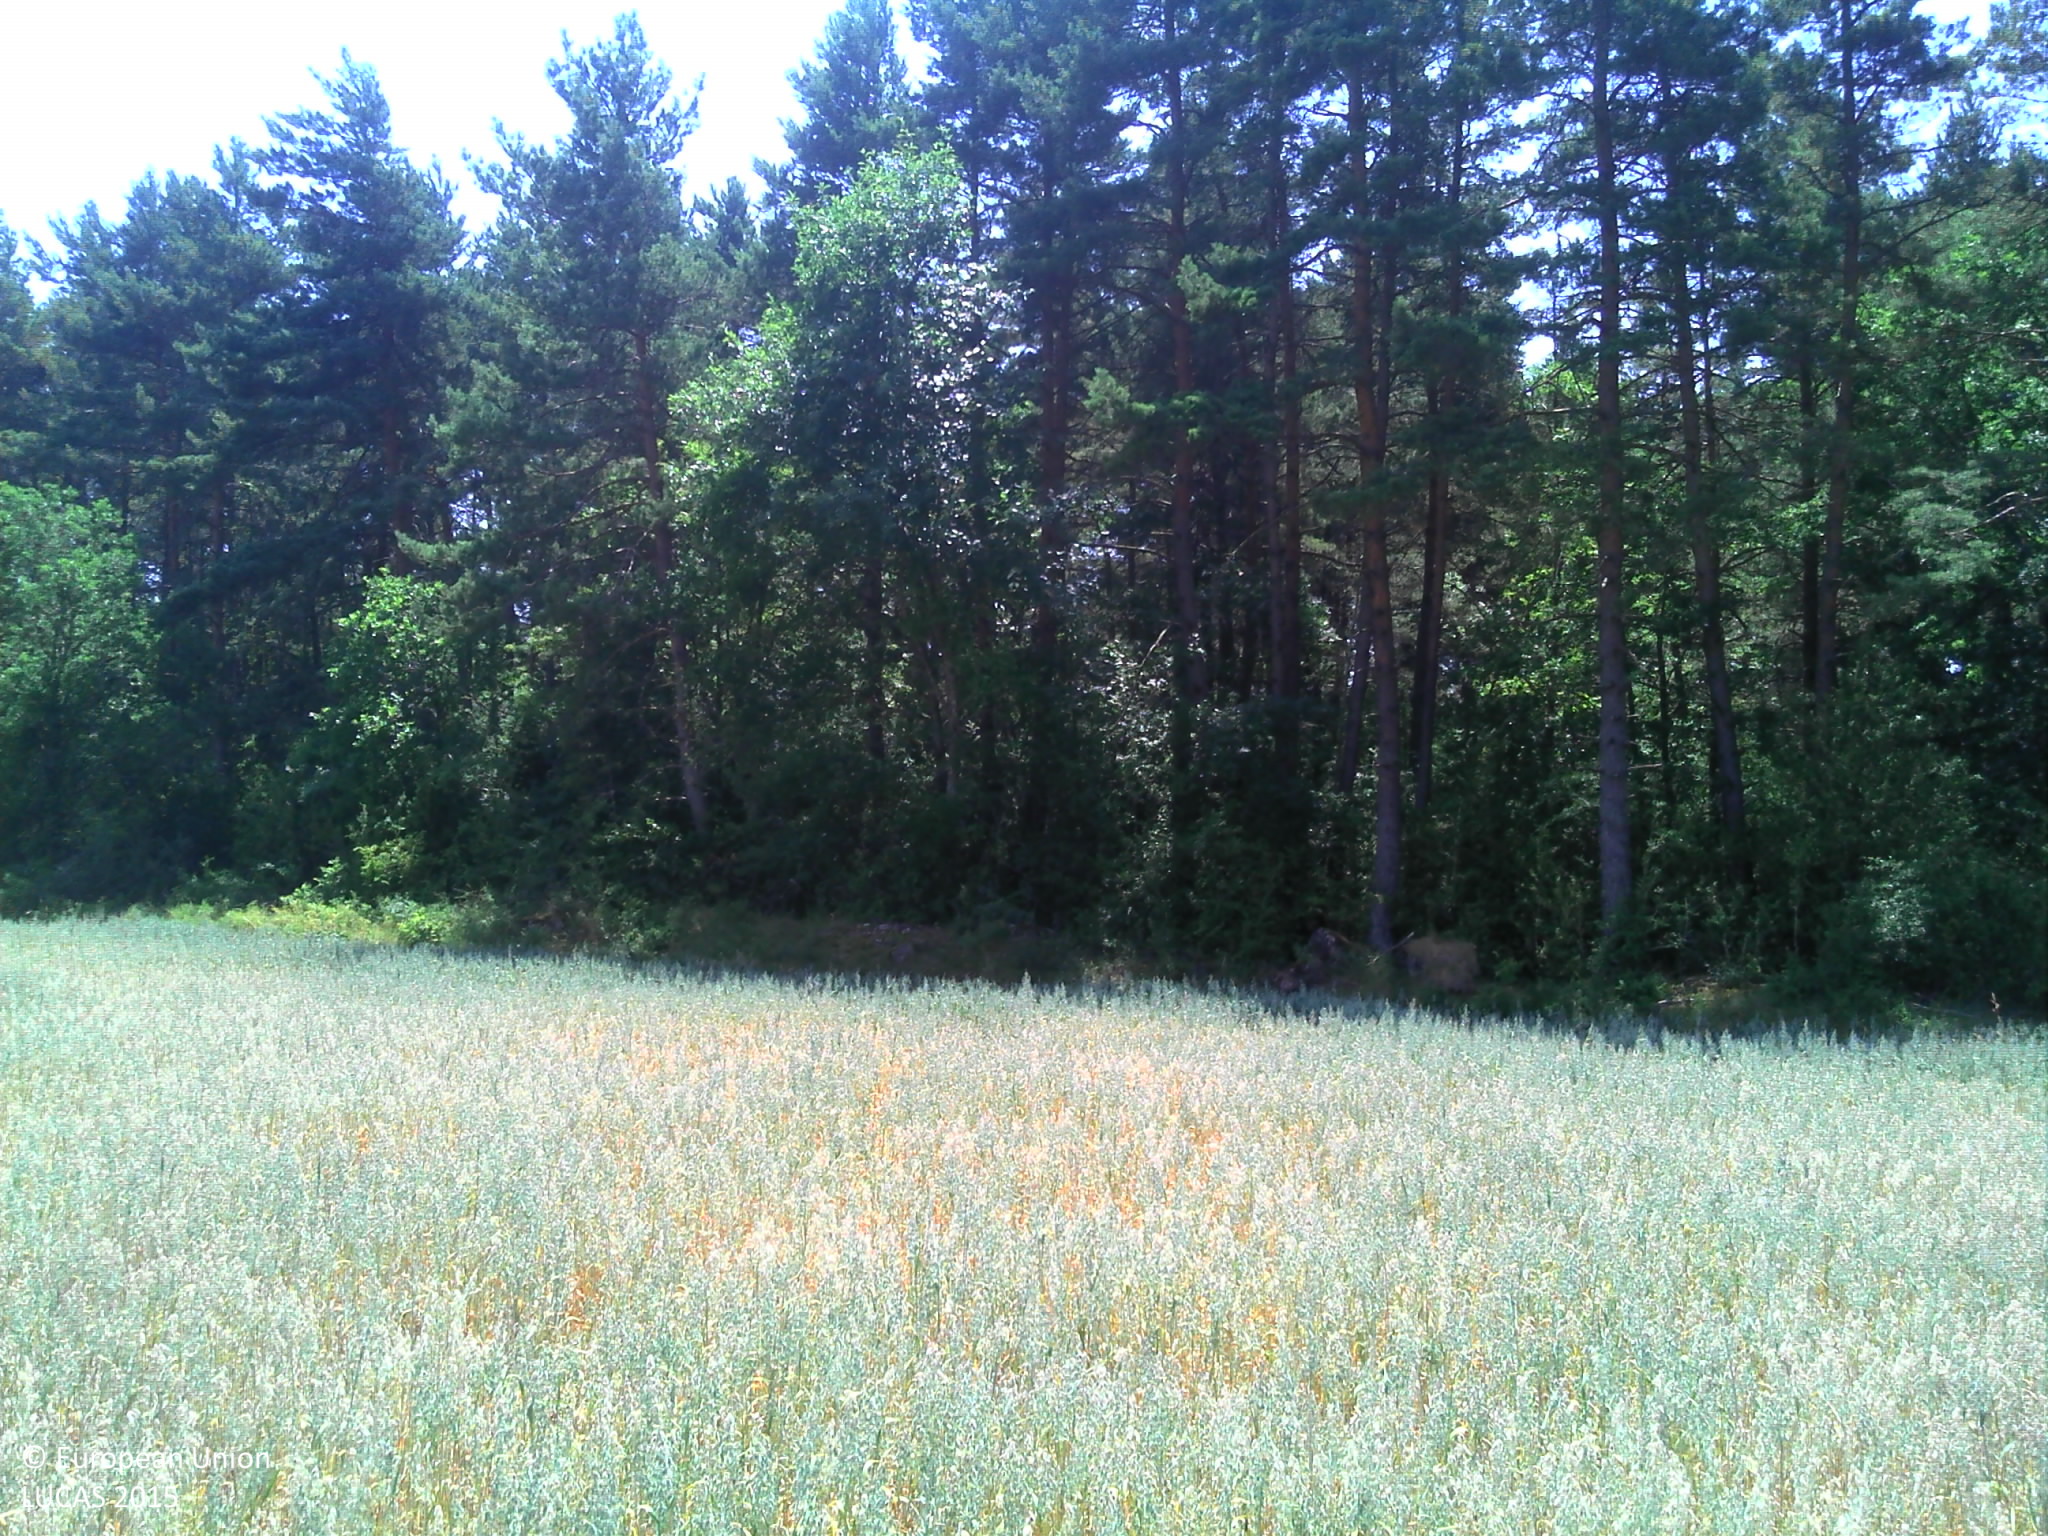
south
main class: Cropland
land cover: Oats
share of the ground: > 75 %
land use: Agriculture (excluding fallow land and kitchen gardens)
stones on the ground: 25 - 50 %
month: July
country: FR
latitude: 44.3131
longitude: 3.2731
